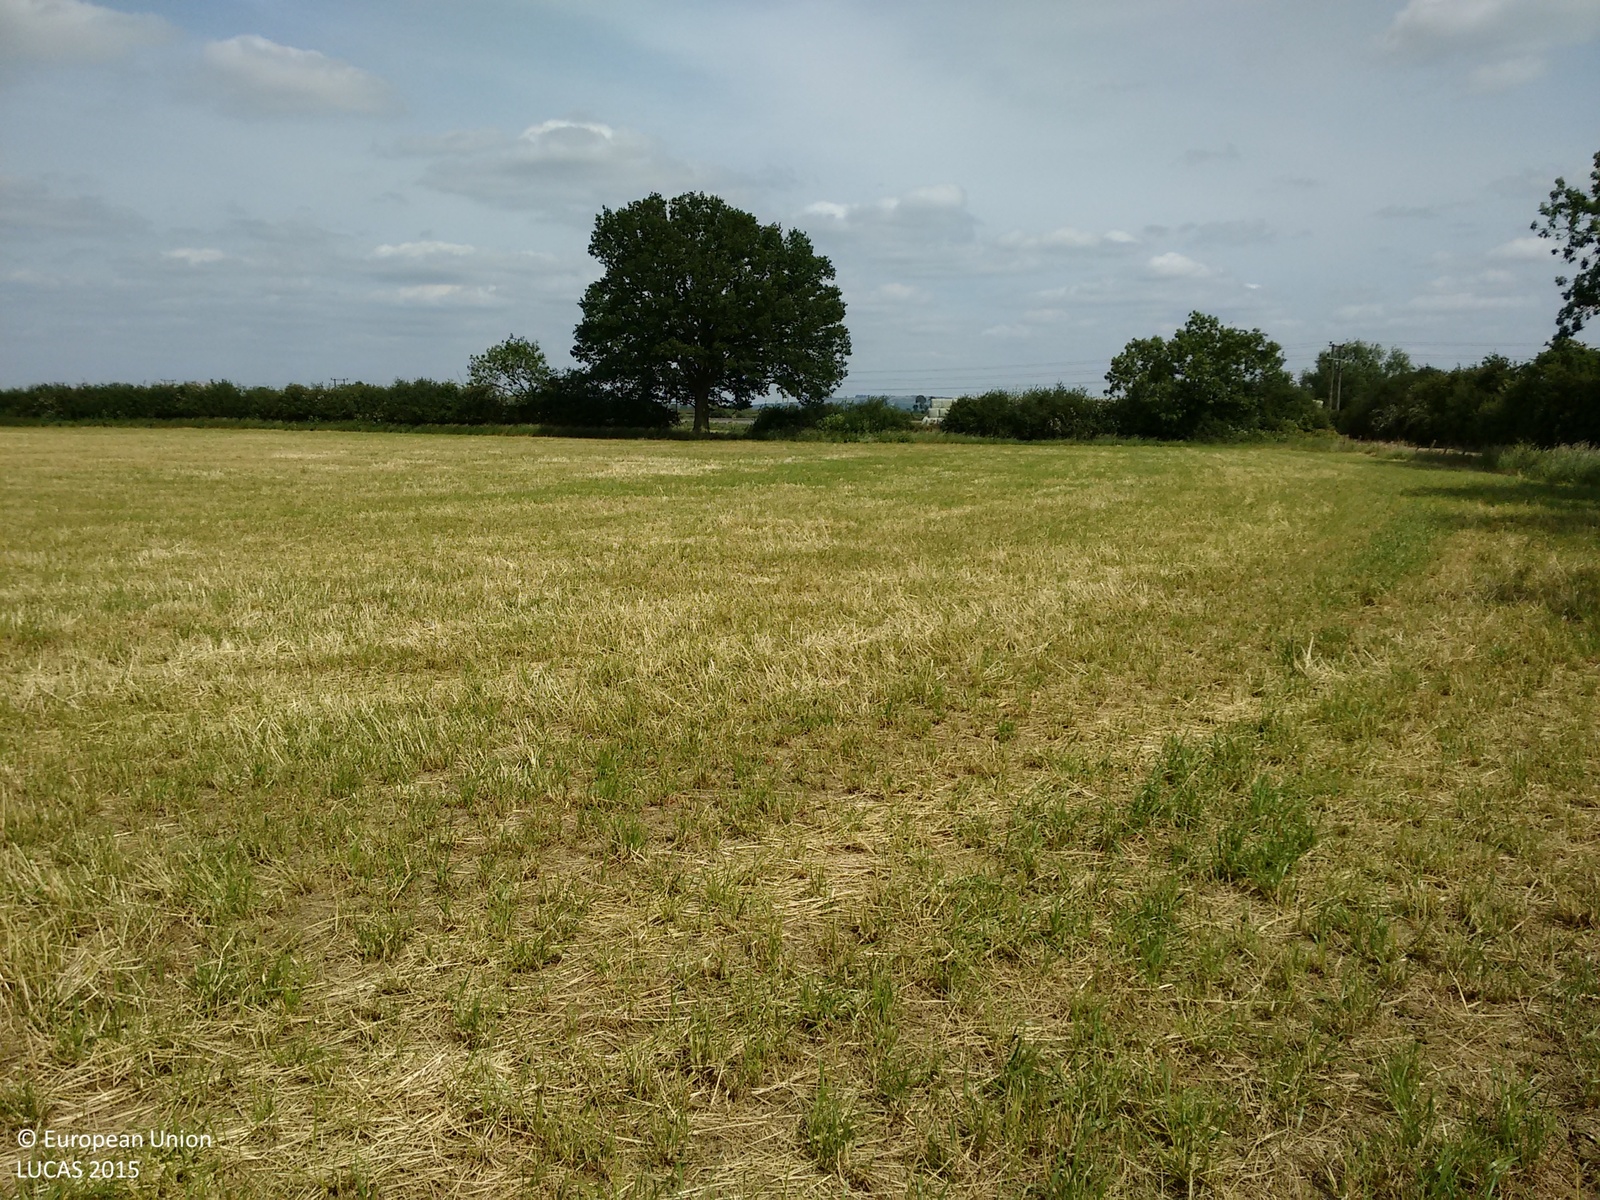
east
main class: Grassland
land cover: Grassland without tree/shrub cover
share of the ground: > 75 %
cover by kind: herbaceous plants 100 %
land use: Agriculture (excluding fallow land and kitchen gardens)
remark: Harvested field
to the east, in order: Grass margins; Grassland without tree/shrub cover; Grass margins; Single bushes/trees; Managed hedges; Grass margins; Grassland without tree/shrub cover; Electric lines; Grassland without tree/shrub cover; Fences; Spontaneously vegetated surfaces
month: June
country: GB
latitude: 51.8447
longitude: -1.2096
